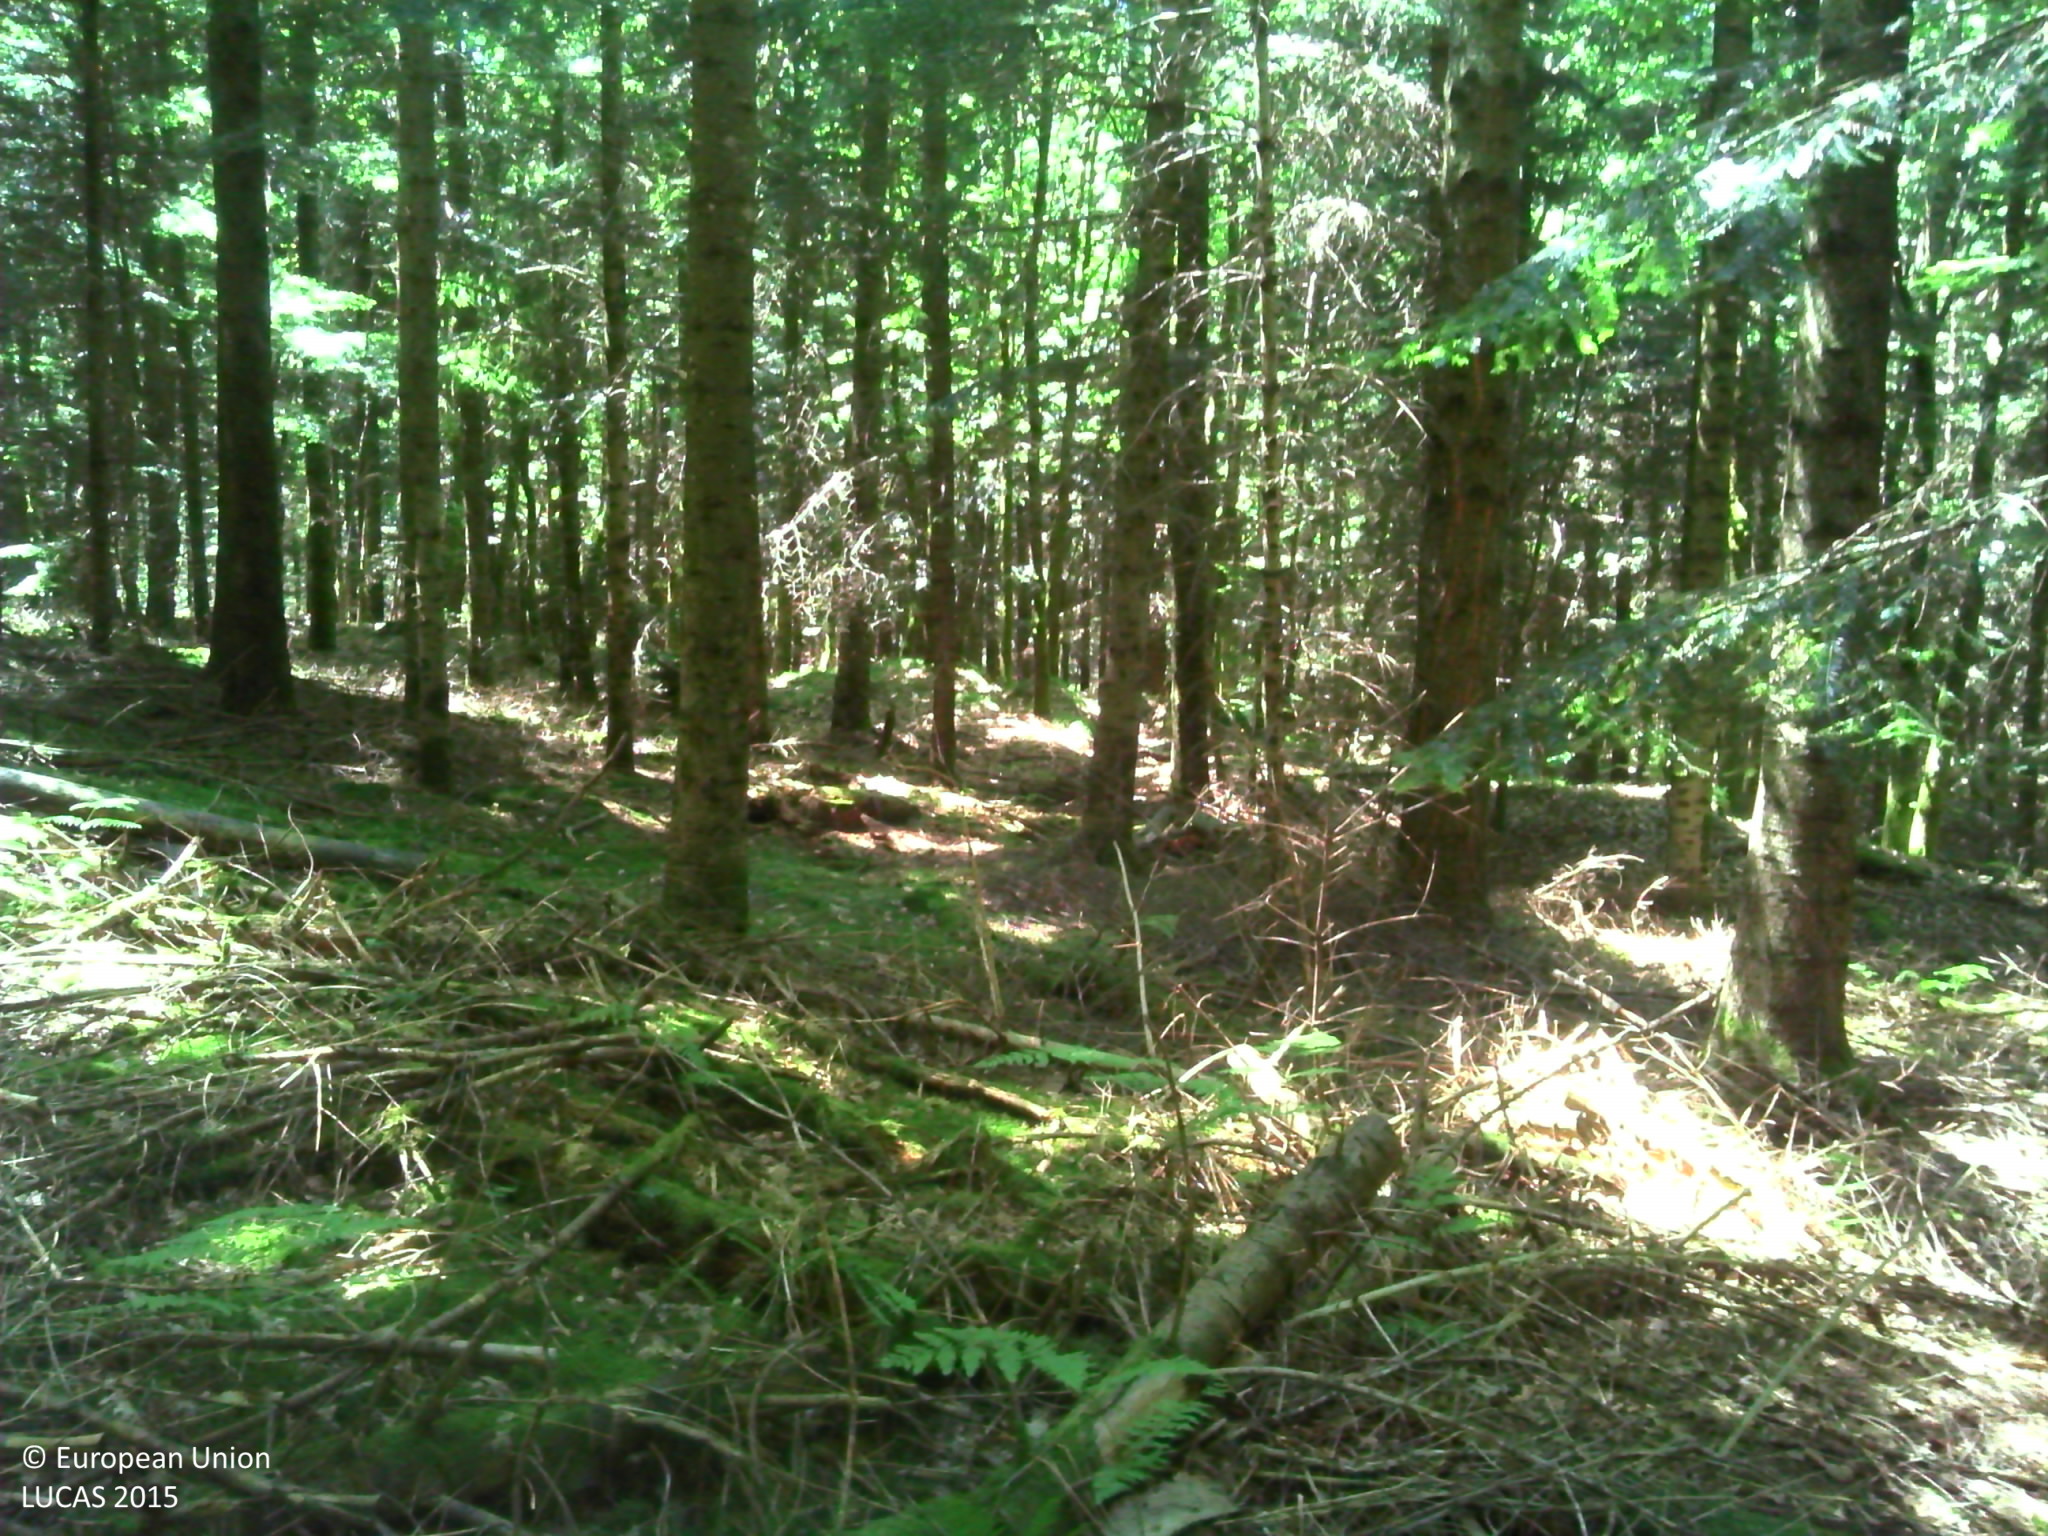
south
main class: Woodland
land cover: Spruce dominated coniferous woodland
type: exotic forest
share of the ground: > 75 %
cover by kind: coniferous forest trees 100 %
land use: Forestry
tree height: > 5 m
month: June
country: FR
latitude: 43.7577
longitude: 2.5662
